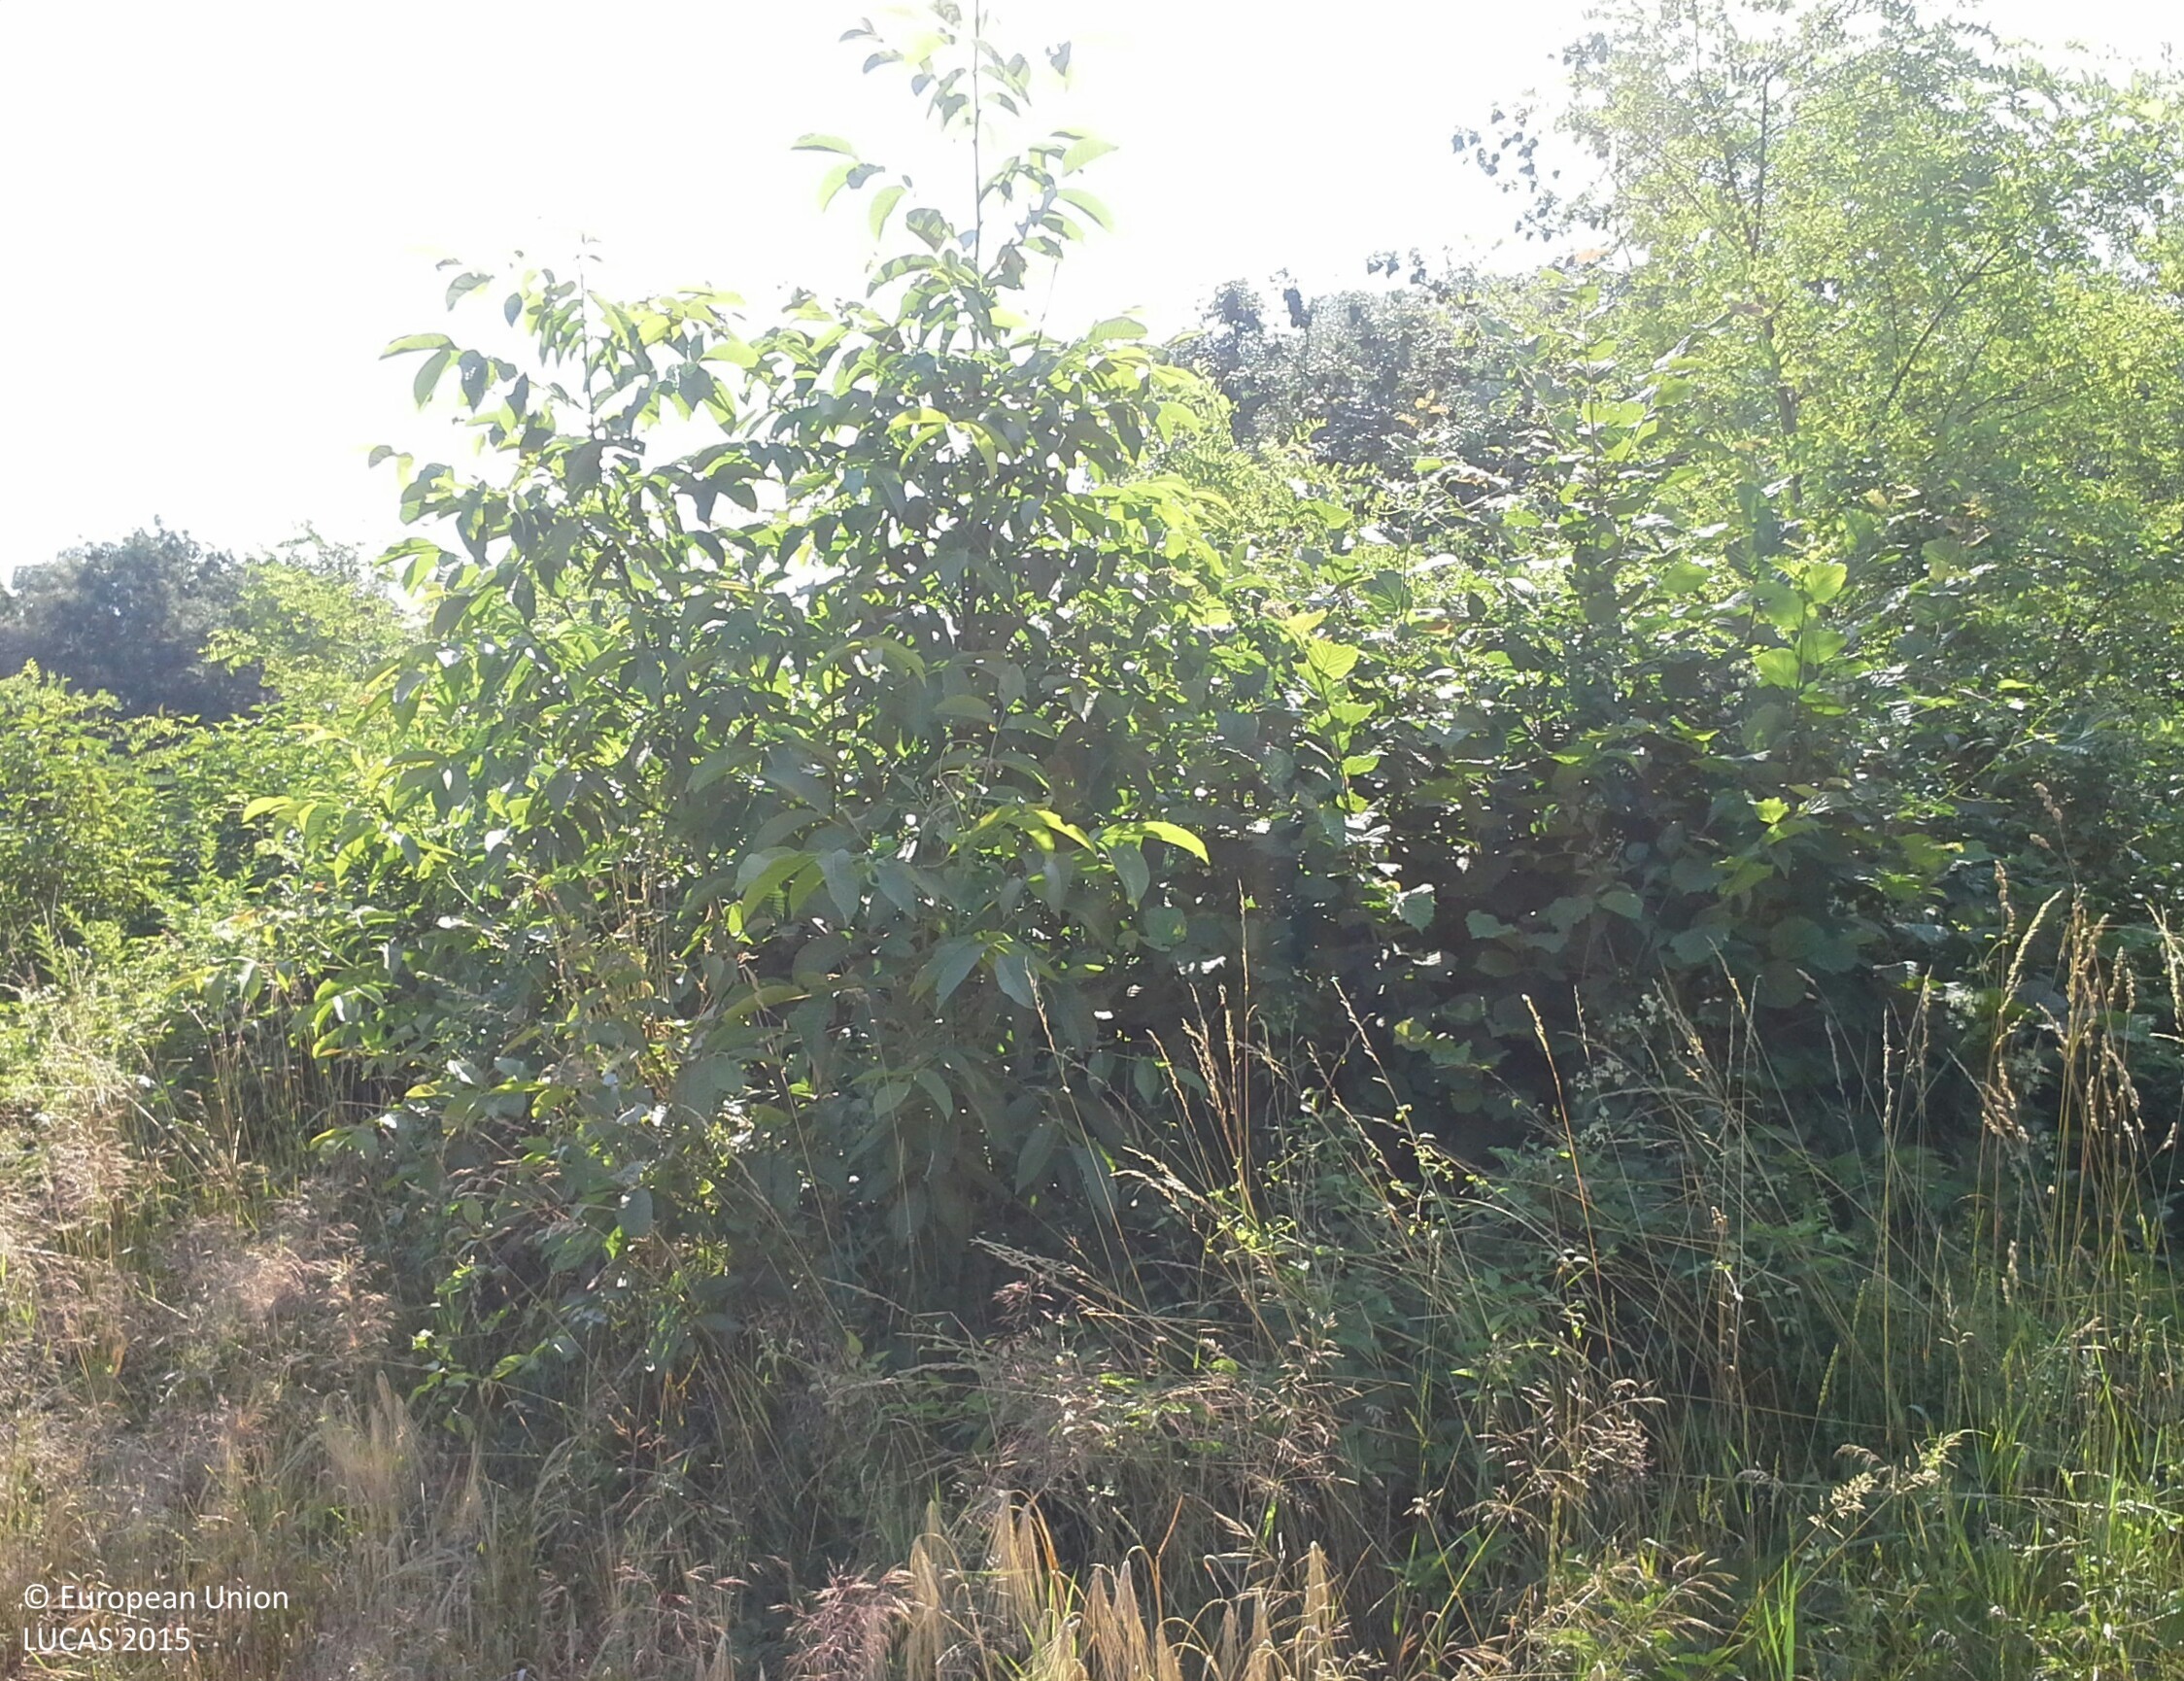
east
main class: Cropland
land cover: Barley
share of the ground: > 75 %
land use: Agriculture (excluding fallow land and kitchen gardens)
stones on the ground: 25 - 50 %
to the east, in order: Barley; Grass margins; Shrubland without tree cover; Inland fresh running water; Paved roads, cycling and walking lanes; Grassland without tree/shrub cover; Tracks; Broadleaved woodland; Inland fresh running water; Broadleaved woodland; Spontaneously vegetated surfaces; Temporary grasslands
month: July
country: AT
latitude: 48.1168
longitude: 14.8500
